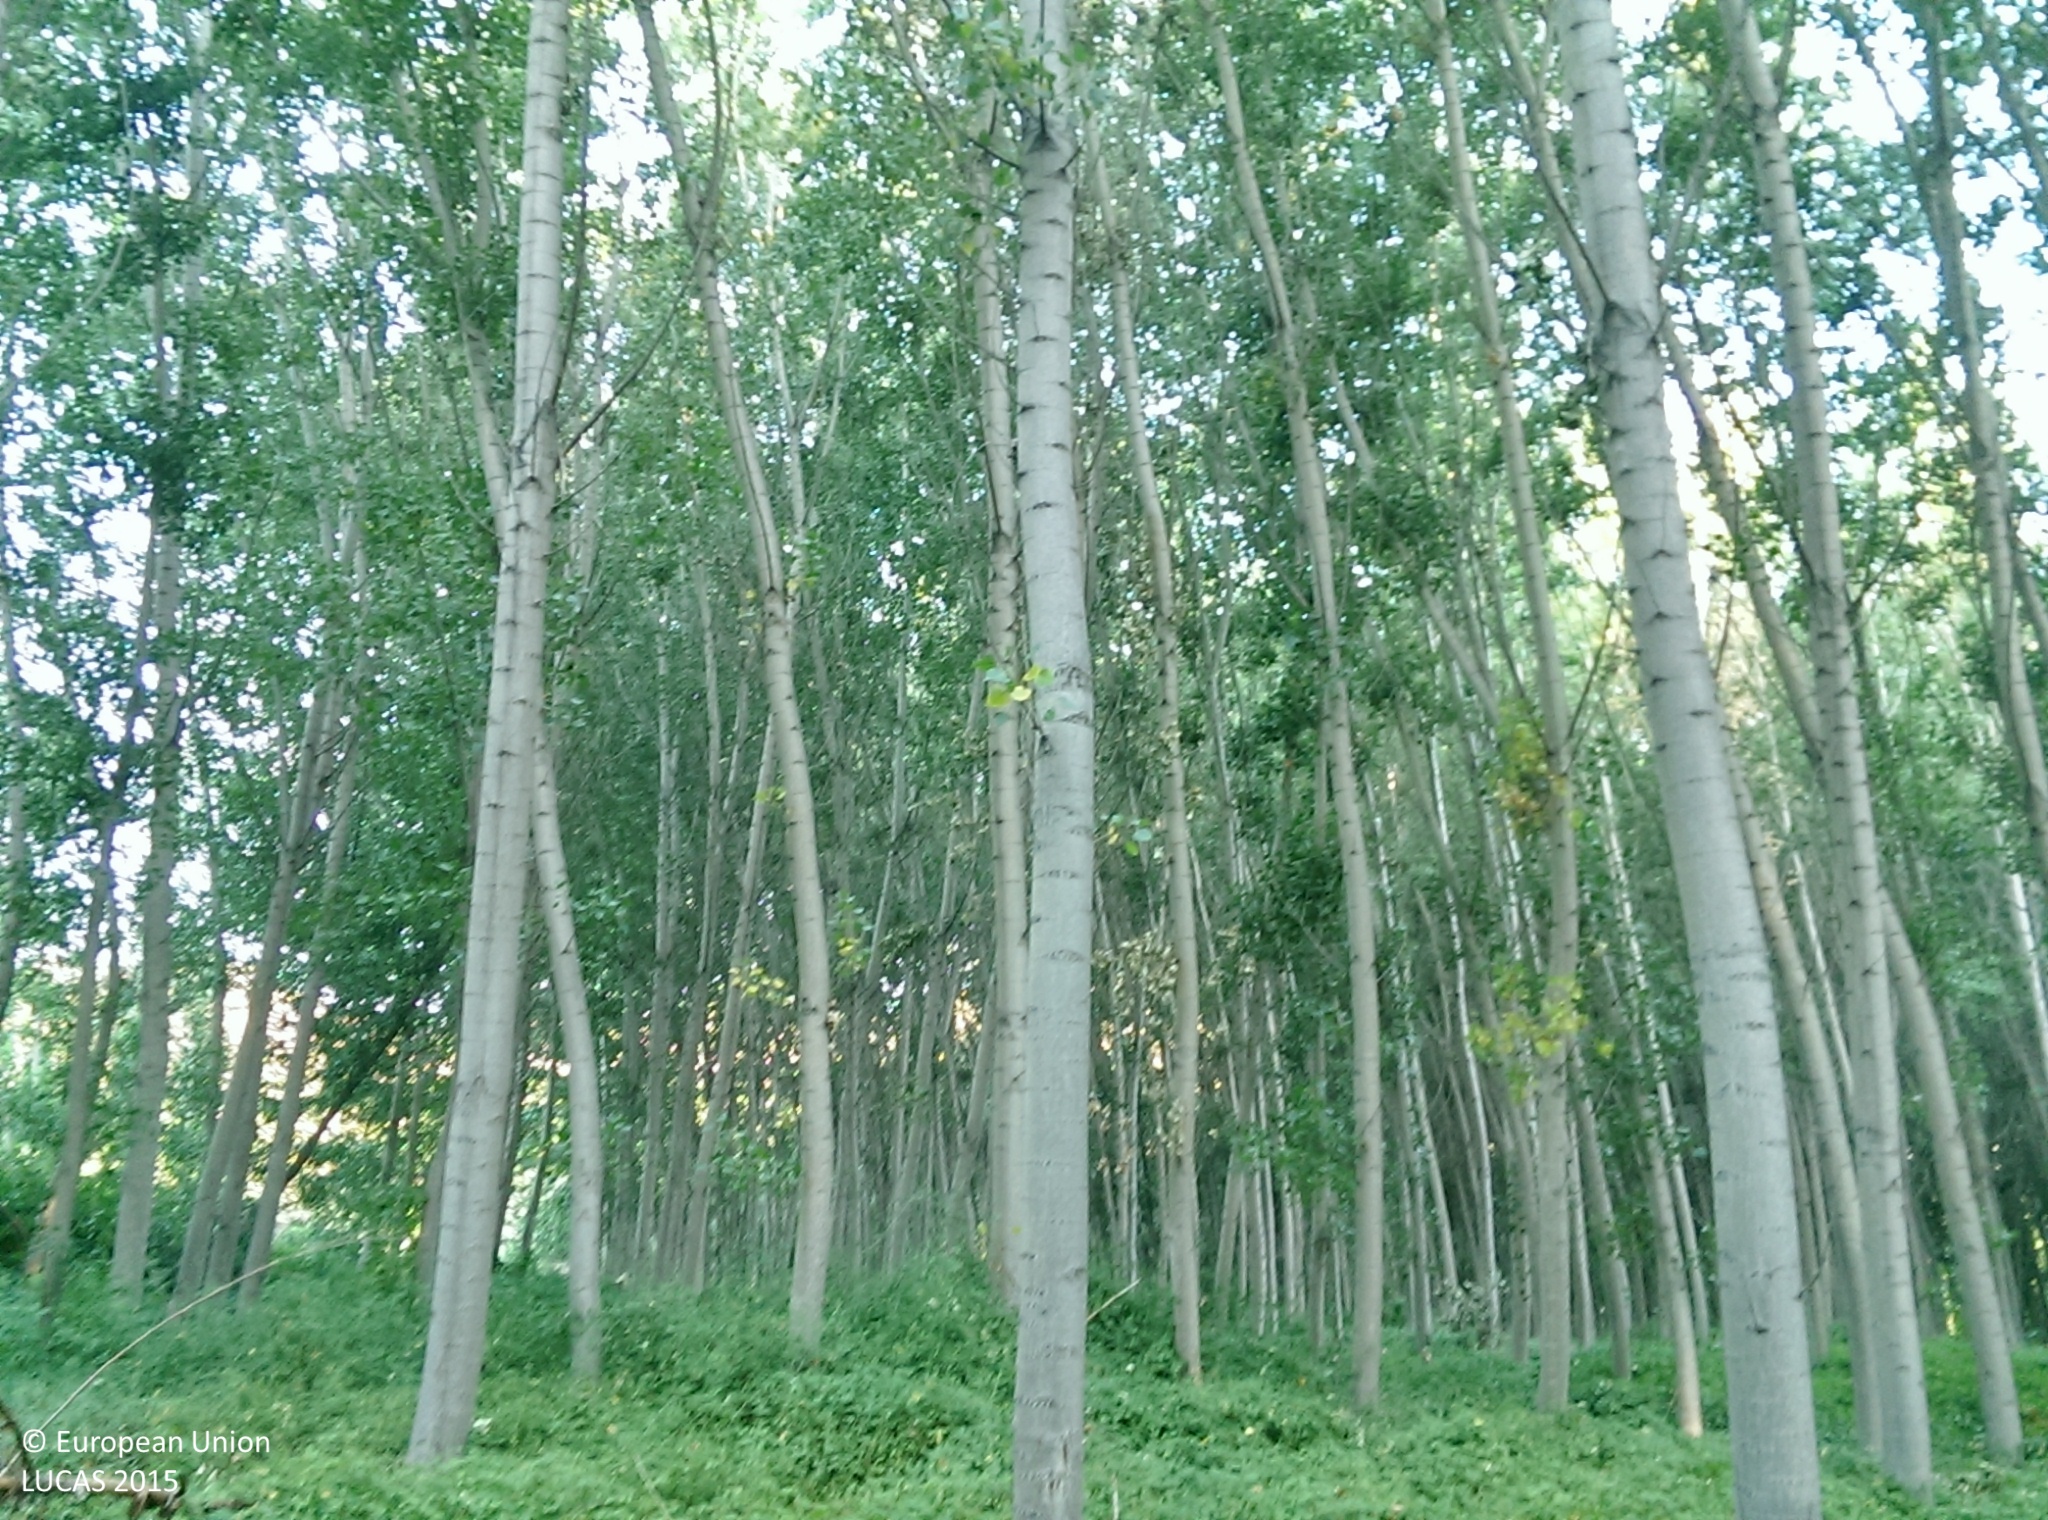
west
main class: Woodland
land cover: Broadleaved woodland
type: exotic forest
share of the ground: > 75 %
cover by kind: broadleaved forest trees 100 %
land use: Forestry
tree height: > 5 m
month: July
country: ES
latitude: 37.3571
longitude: -3.1864
